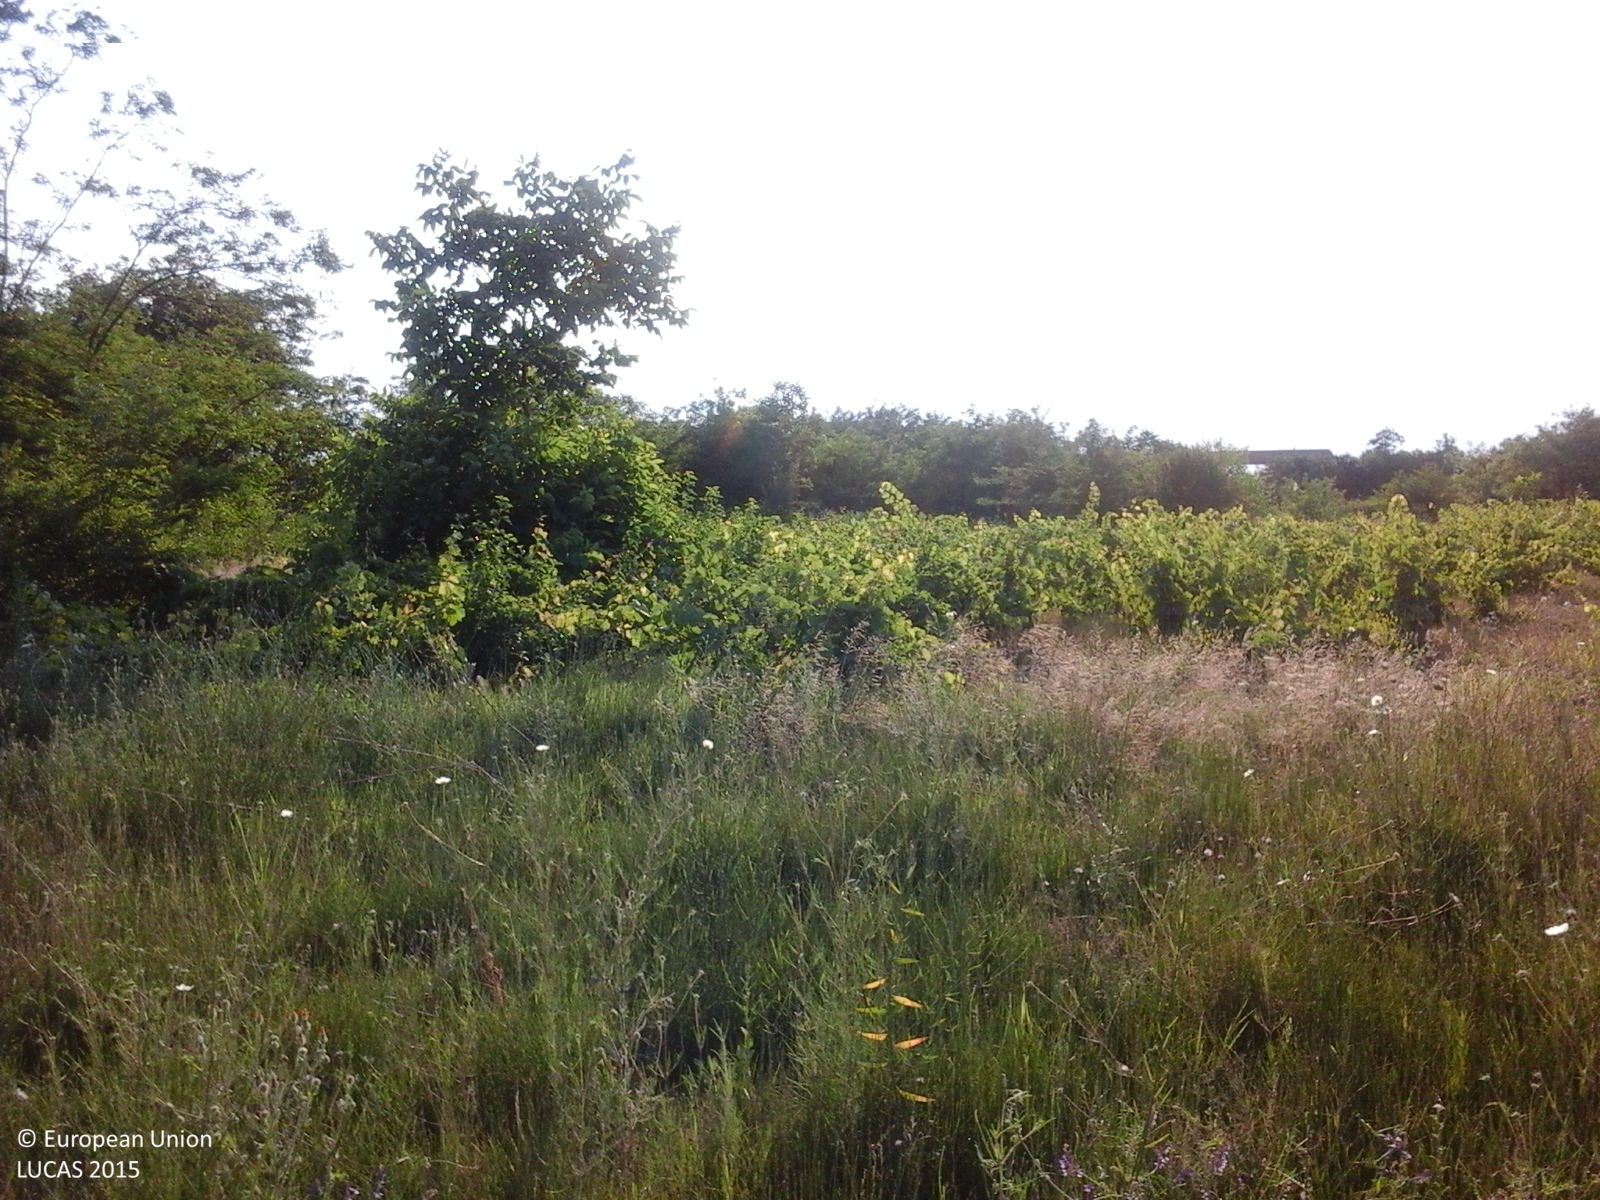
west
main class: Grassland
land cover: Grassland without tree/shrub cover
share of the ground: > 75 %
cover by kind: herbaceous plants 100 %
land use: Agriculture (excluding fallow land and kitchen gardens)
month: July
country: RO
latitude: 43.7729
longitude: 24.1842
